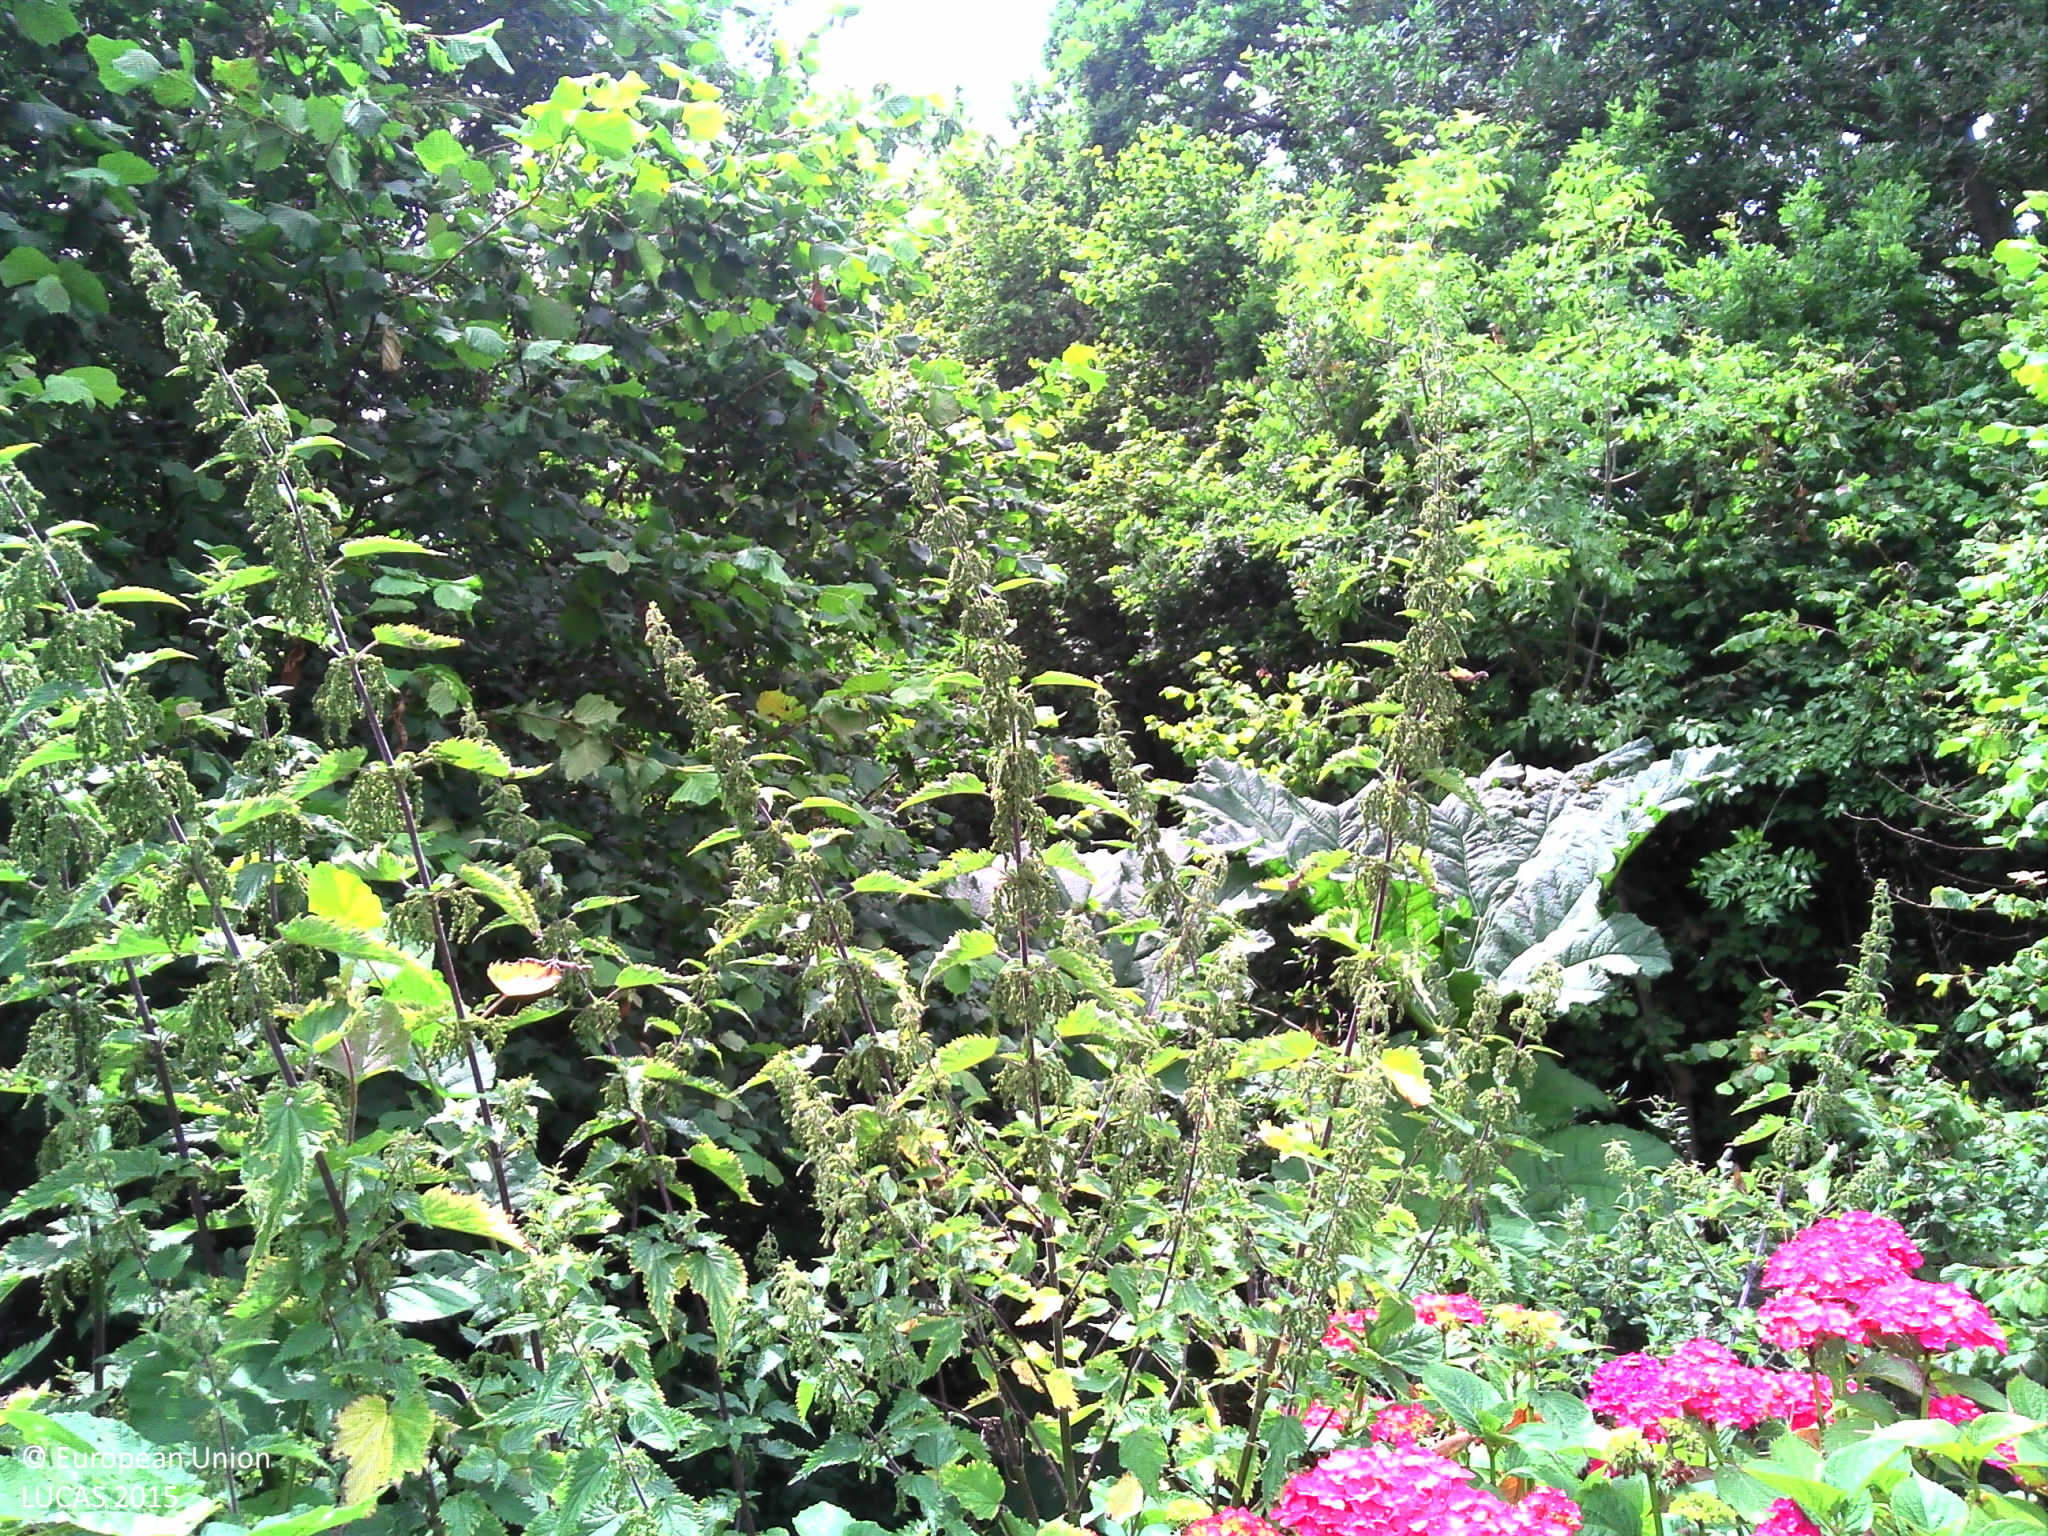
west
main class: Grassland
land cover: Spontaneously vegetated surfaces
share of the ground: > 75 %
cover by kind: herbaceous plants 100 %
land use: Semi-natural and natural areas not in use
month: July
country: FR
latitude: 48.7382
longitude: -3.5007
